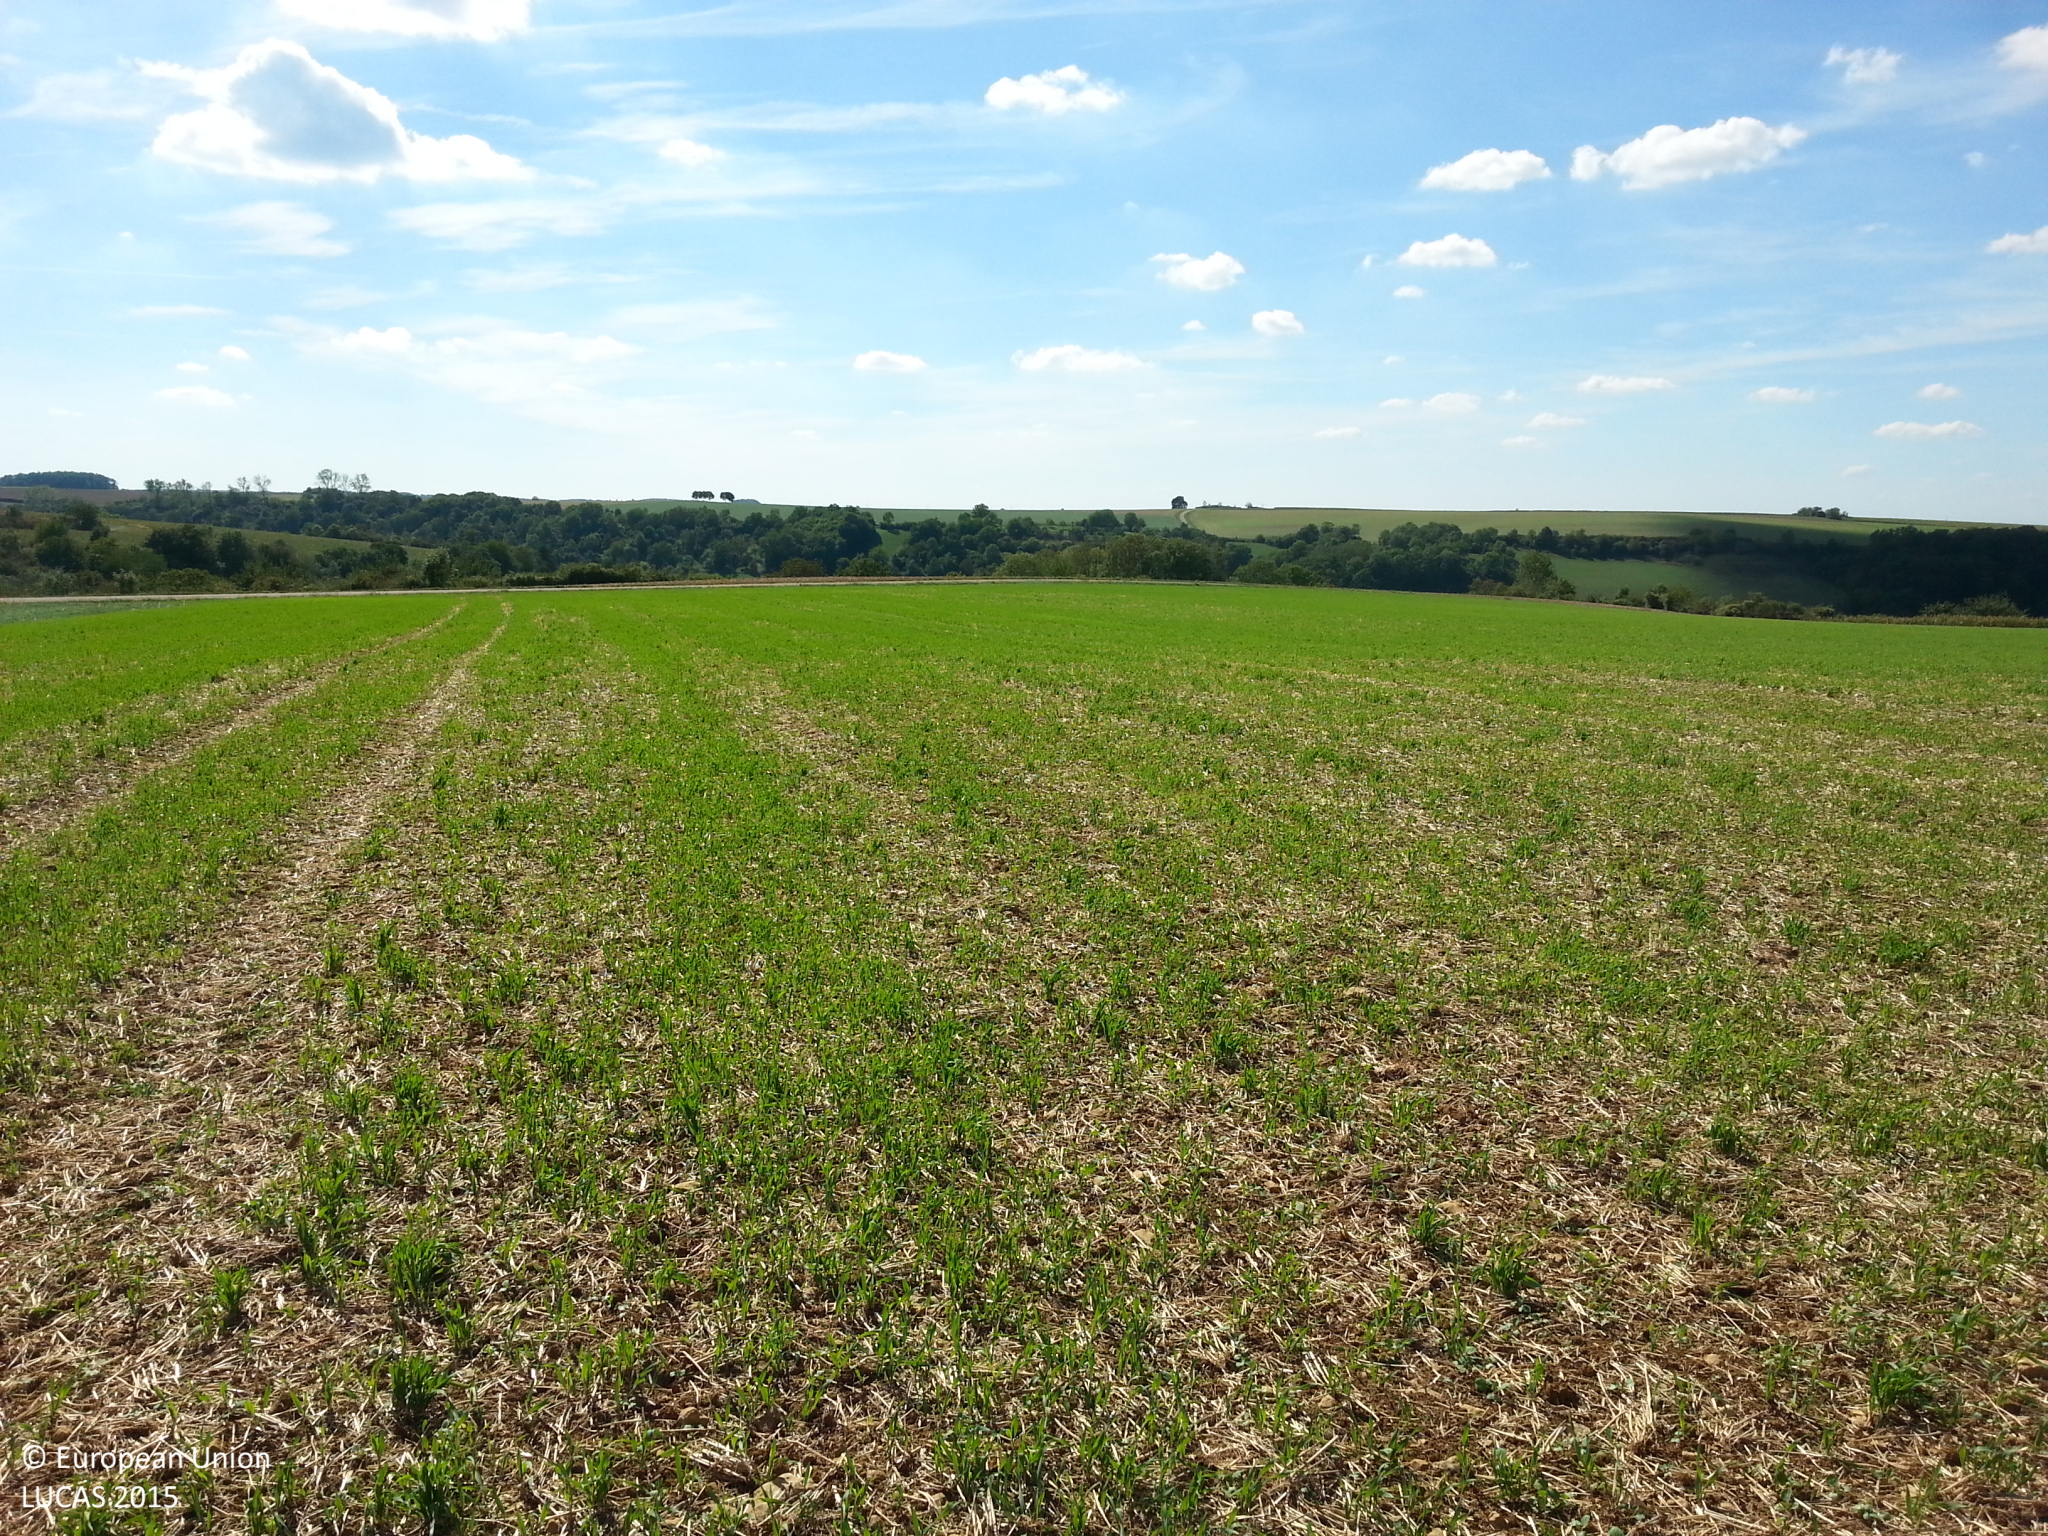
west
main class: Cropland
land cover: Temporary grasslands
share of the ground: 50 - 75 %
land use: Agriculture (excluding fallow land and kitchen gardens)
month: August
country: DE
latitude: 49.4289
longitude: 9.9587
